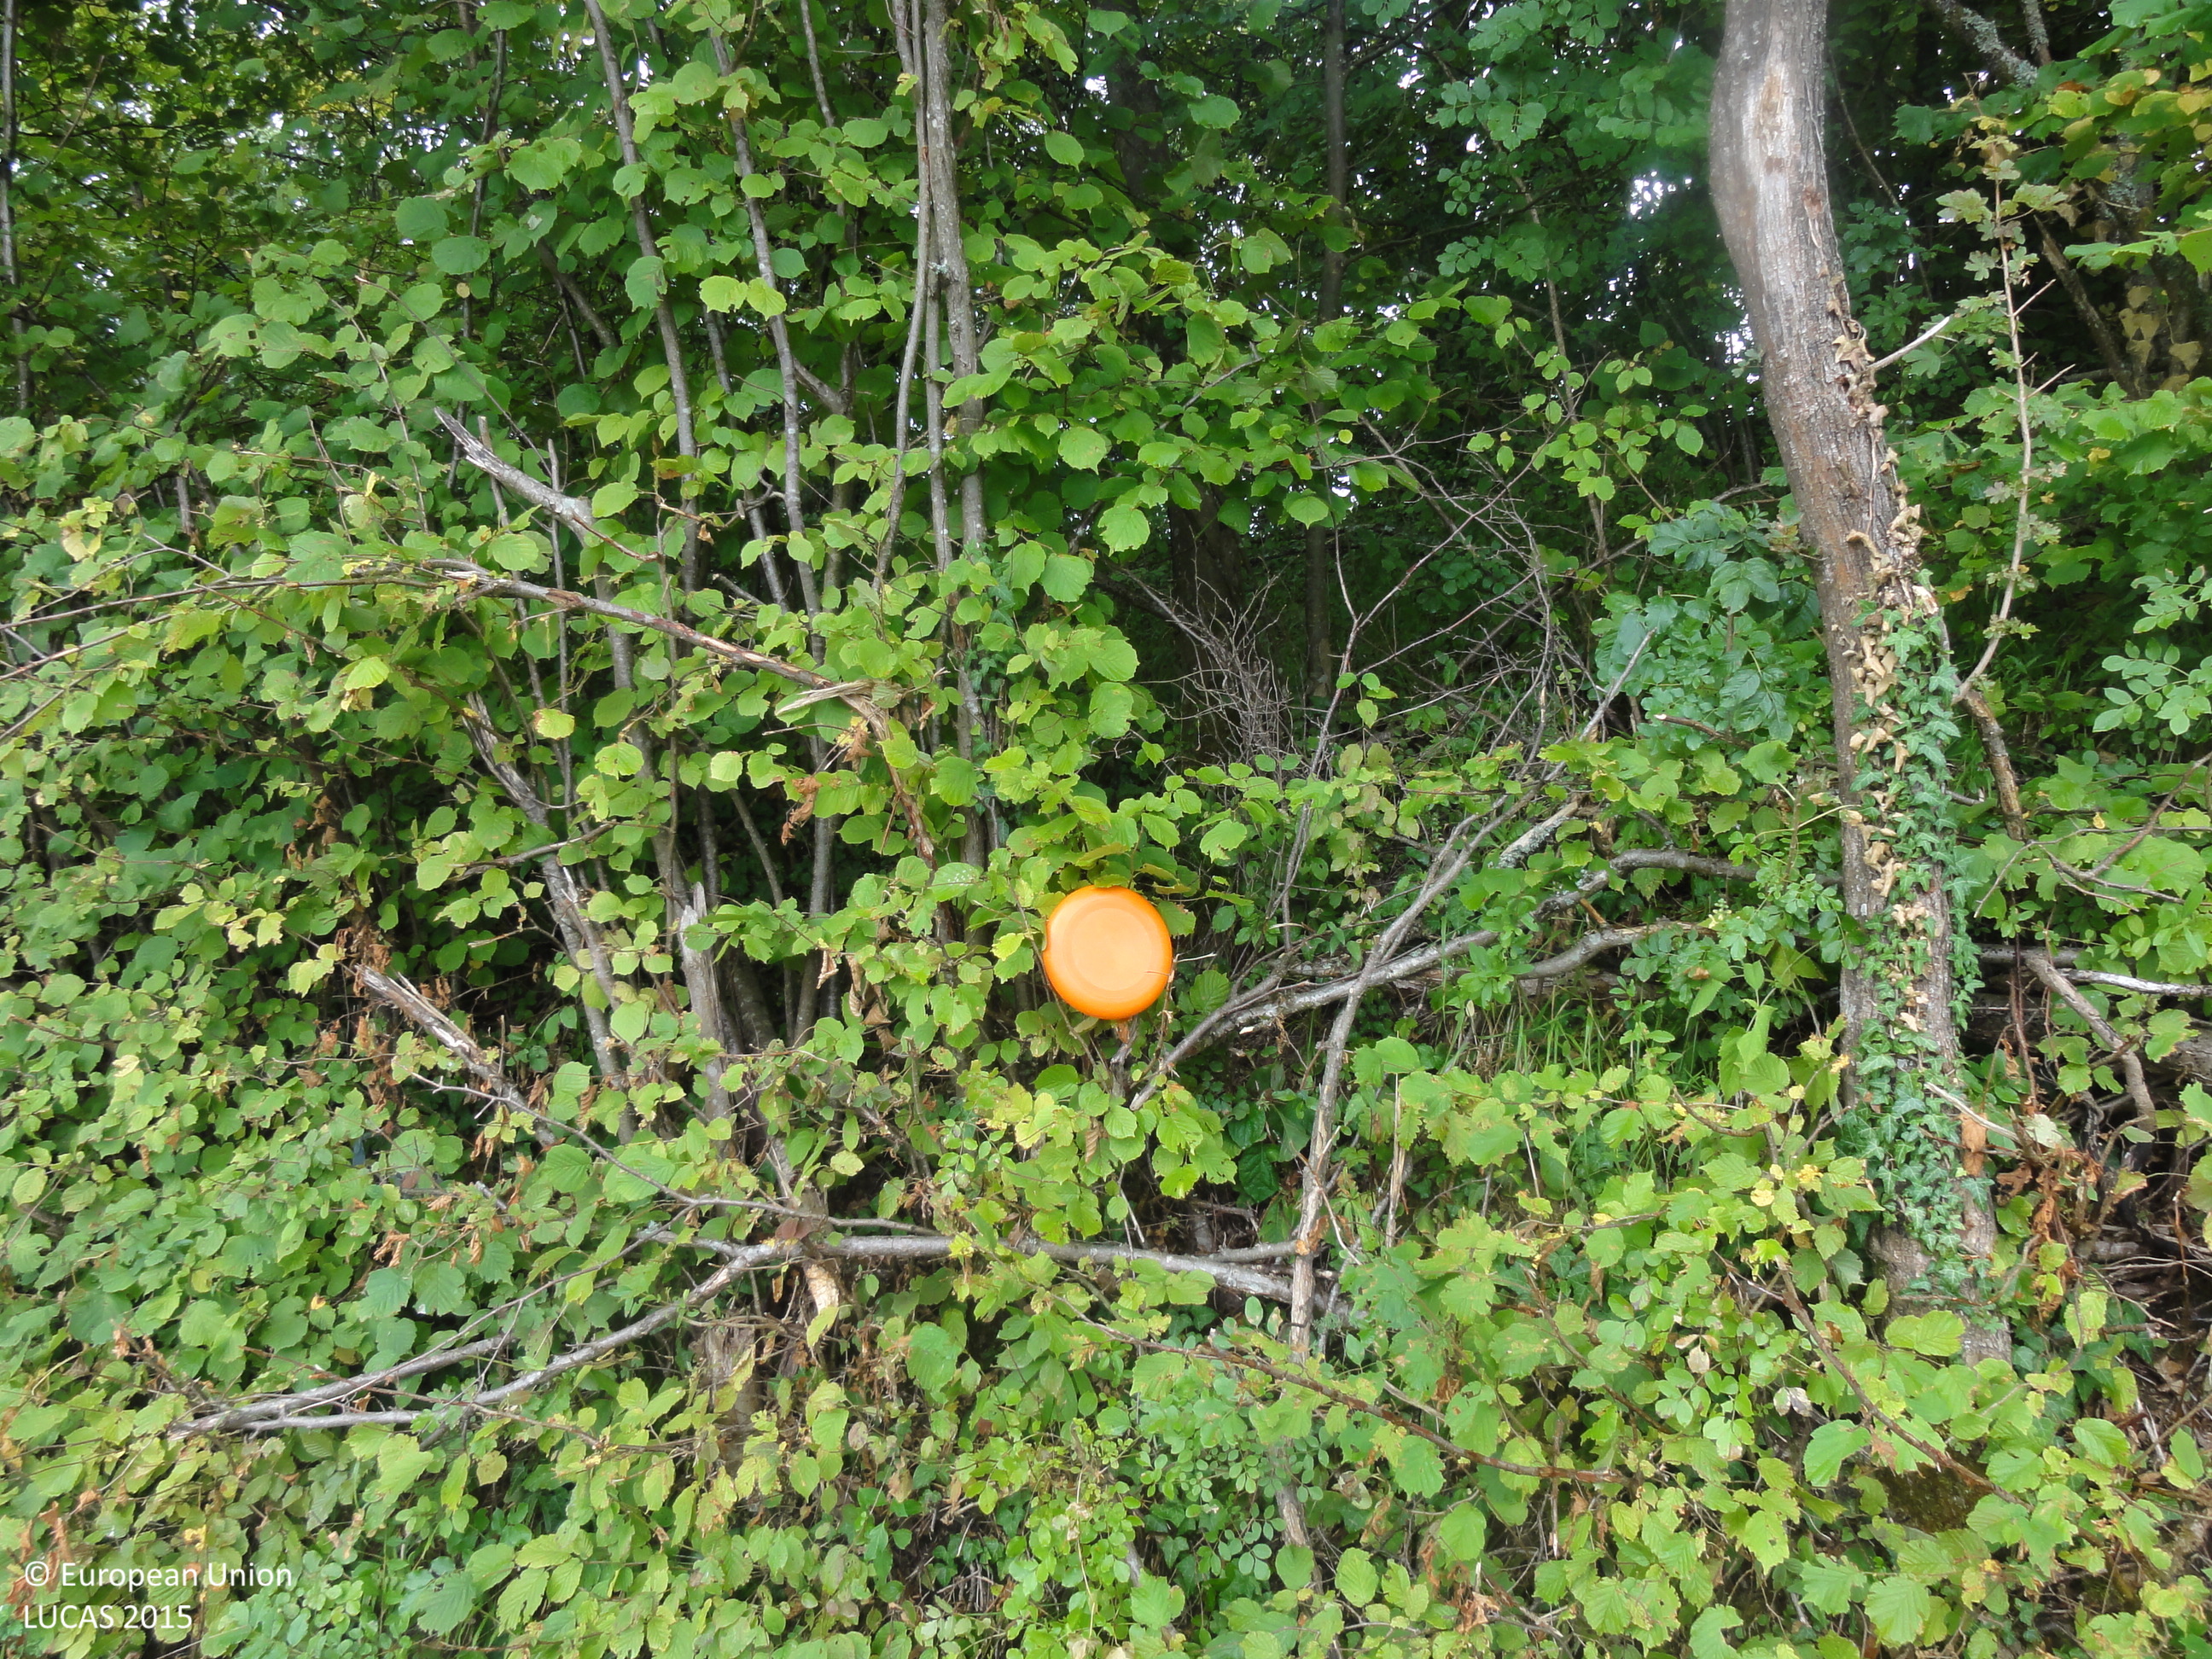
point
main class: Woodland
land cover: Broadleaved woodland
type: mesophytic deciduous forest
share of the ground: > 75 %
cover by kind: broadleaved forest trees 85 %, shrubs 10 %, coniferous forest trees 5 %
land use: Forestry
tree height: > 5 m
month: August
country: SI
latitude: 45.9939
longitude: 15.1226
